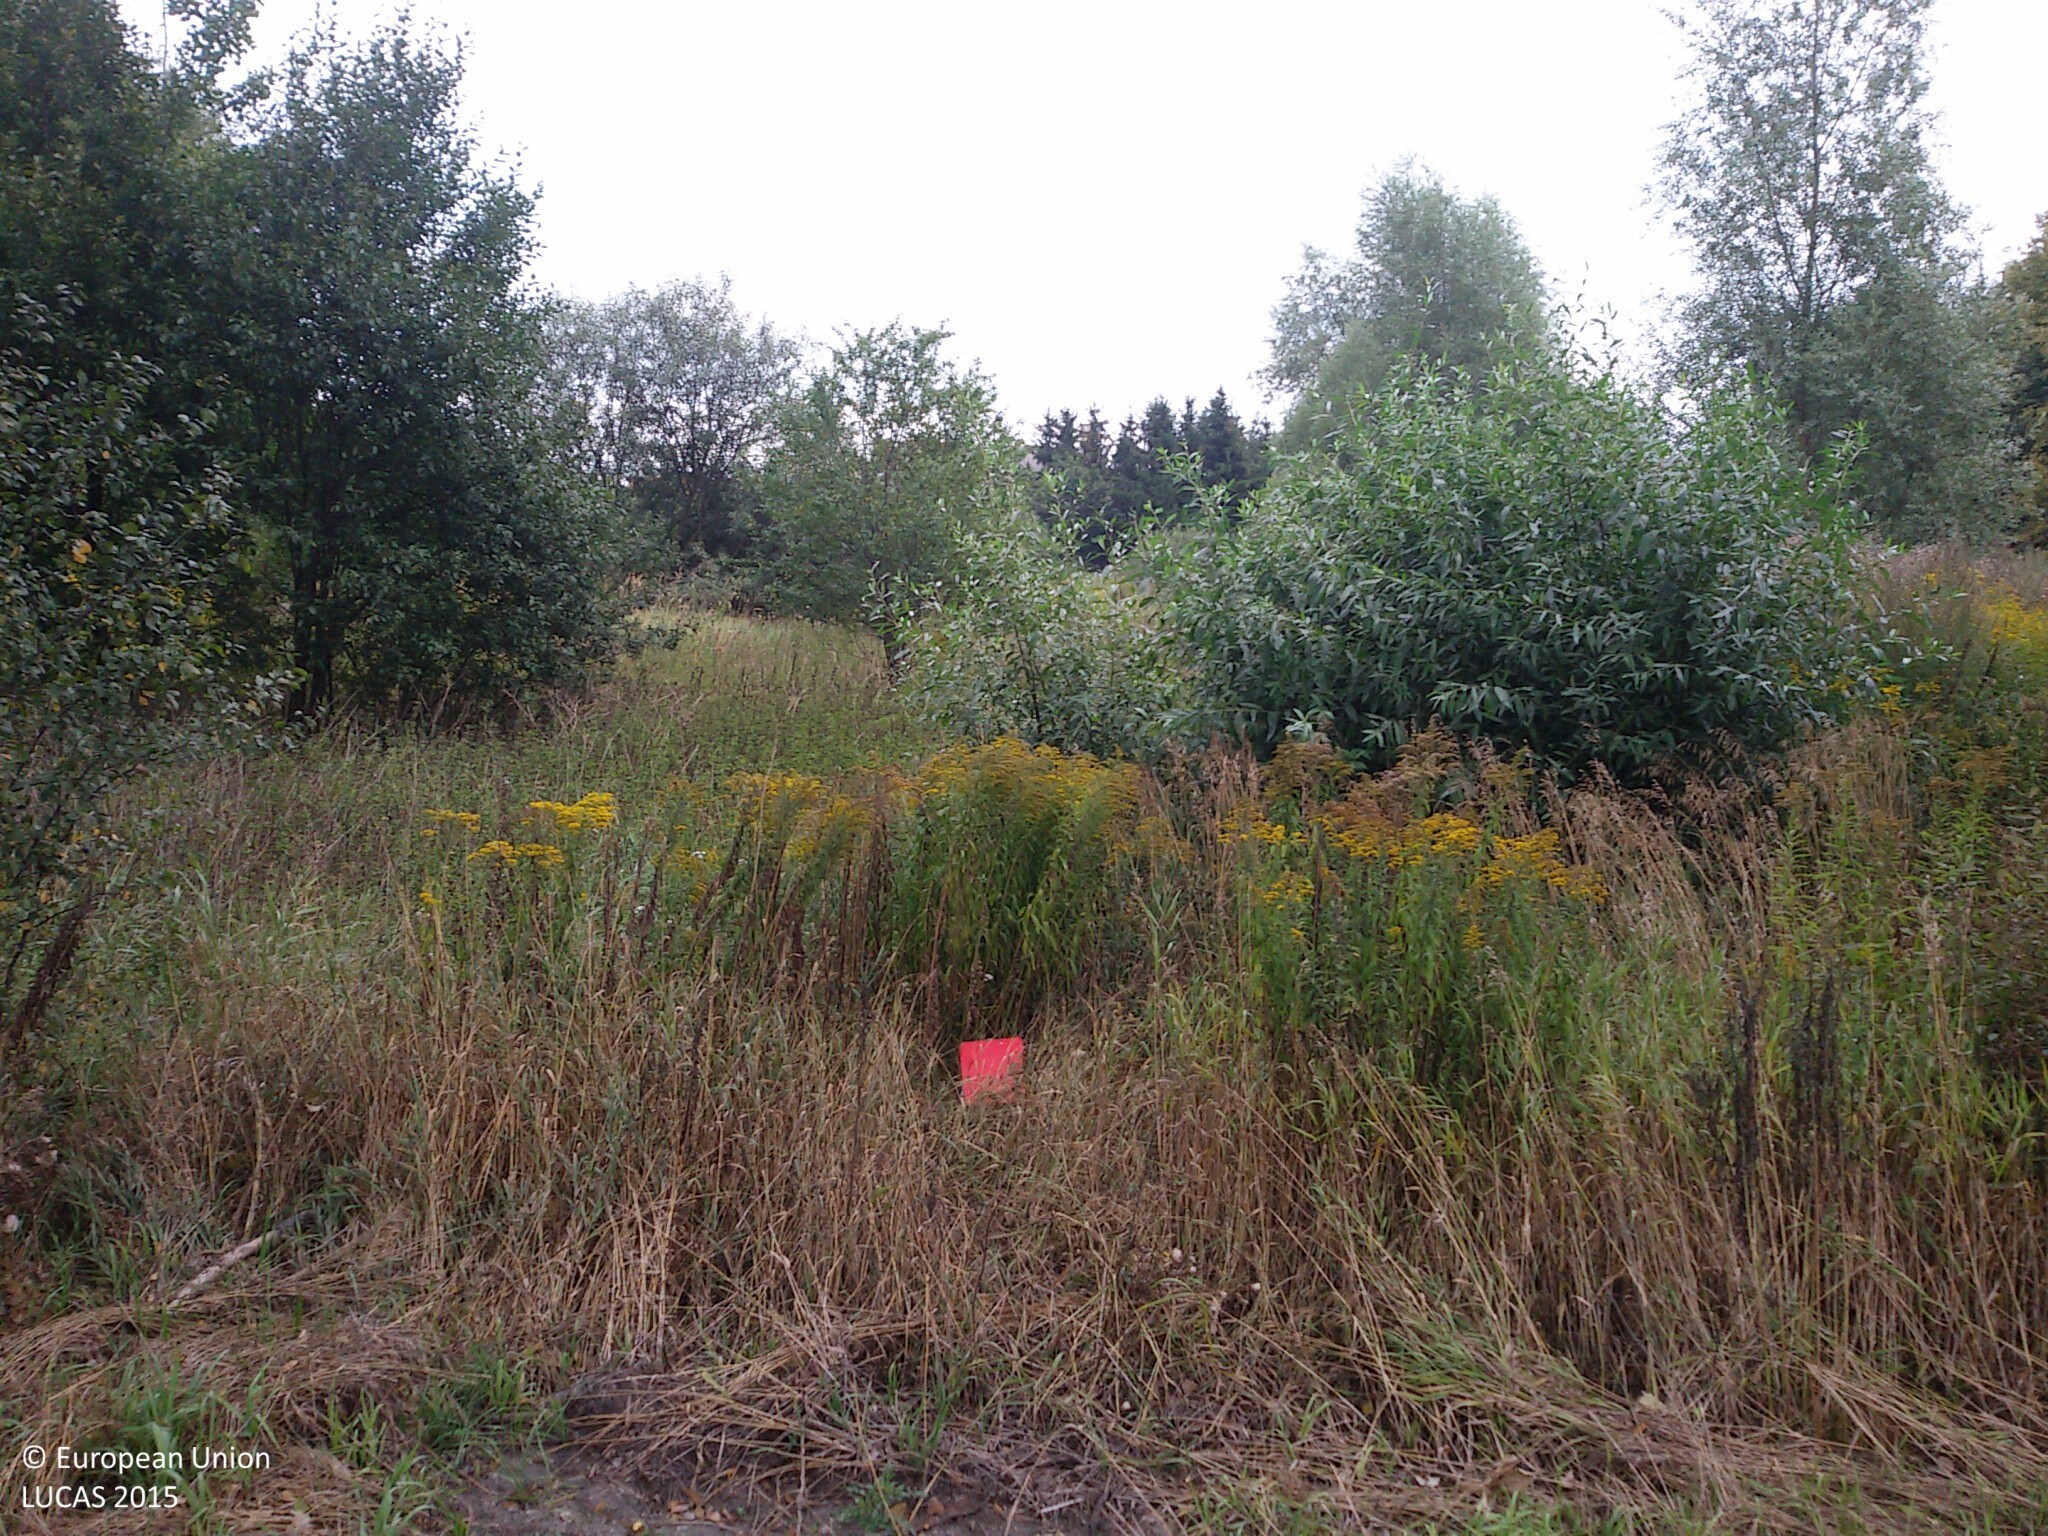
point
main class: Grassland
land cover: Grassland with sparse tree/shrub cover
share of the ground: > 75 %
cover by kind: herbaceous plants 85 %, shrubs 10 %, broadleaved forest trees 5 %
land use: Abandoned areas
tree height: > 5 m
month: September
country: PL
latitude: 53.7311
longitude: 20.2047
